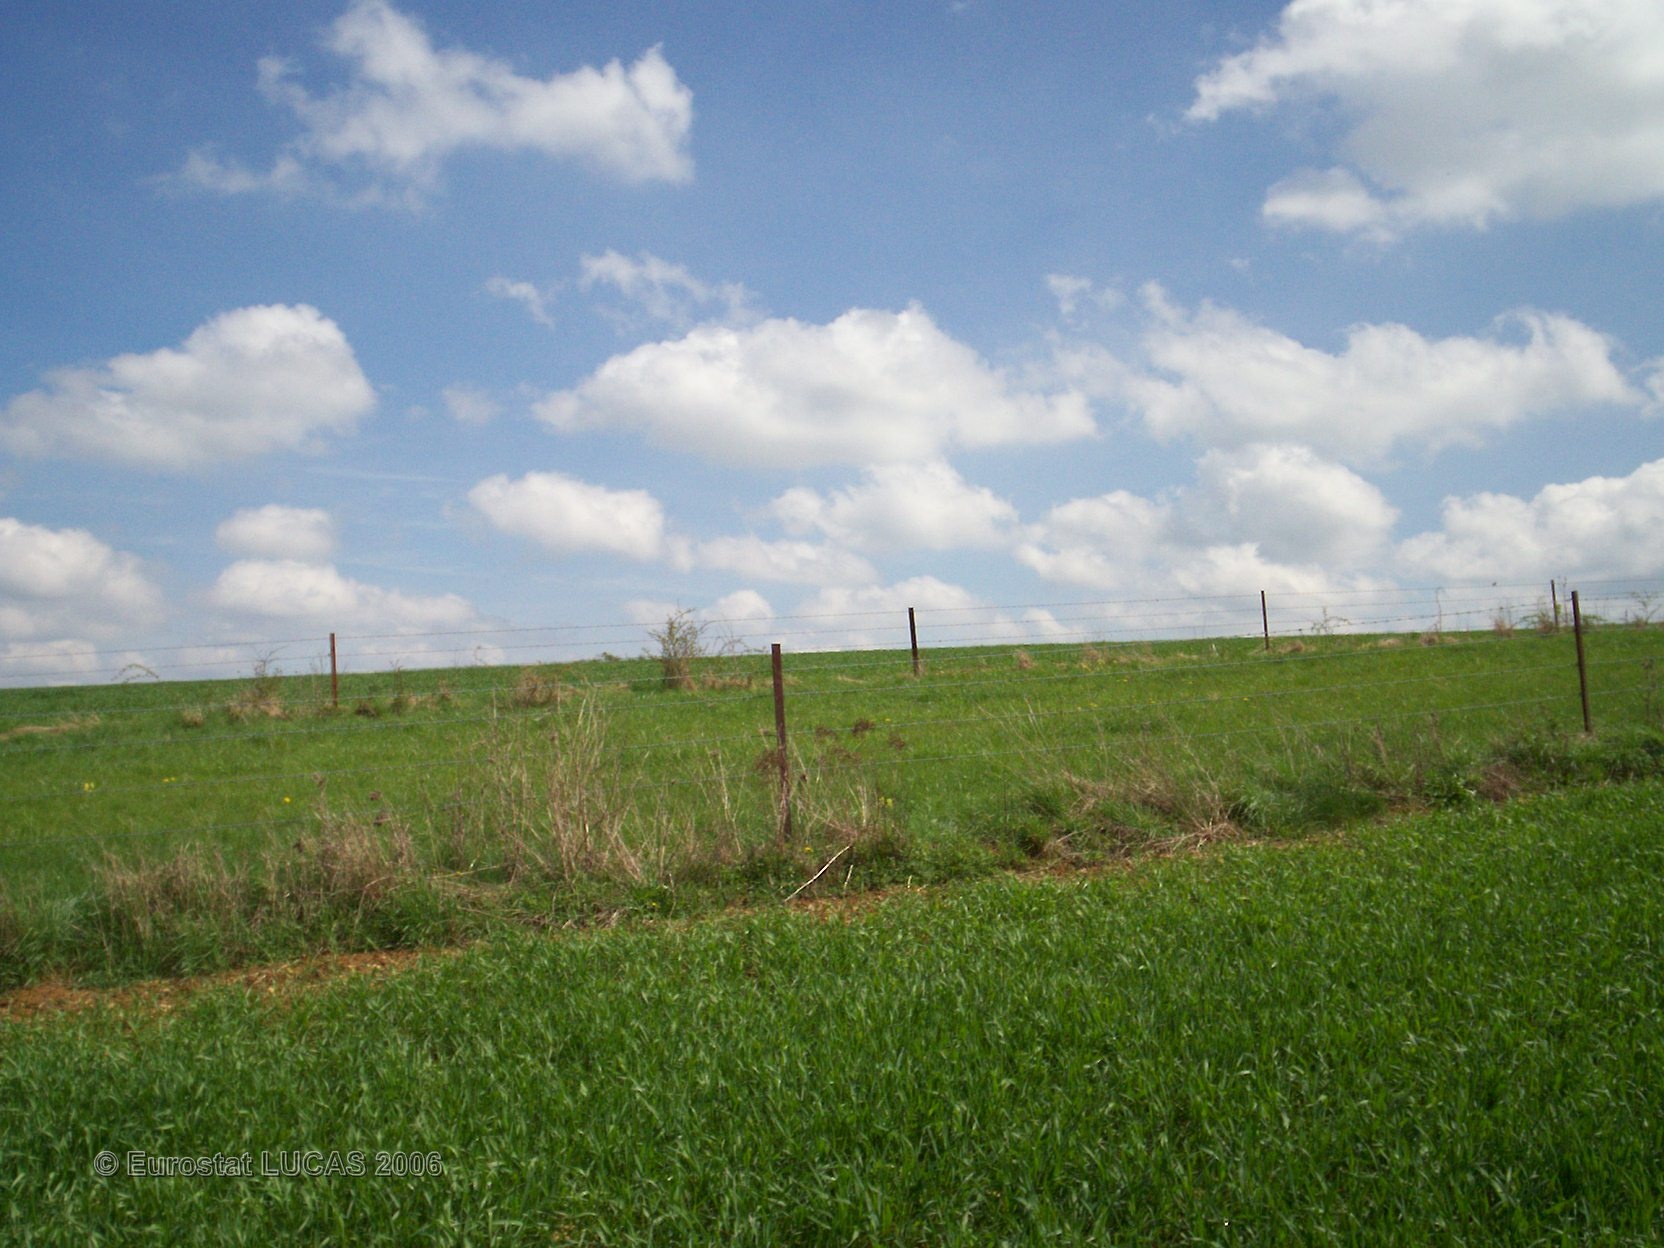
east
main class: Cropland
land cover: Common wheat
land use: Agriculture (excluding fallow land and kitchen gardens)
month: May
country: FR
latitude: 49.8121
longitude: 4.3953
